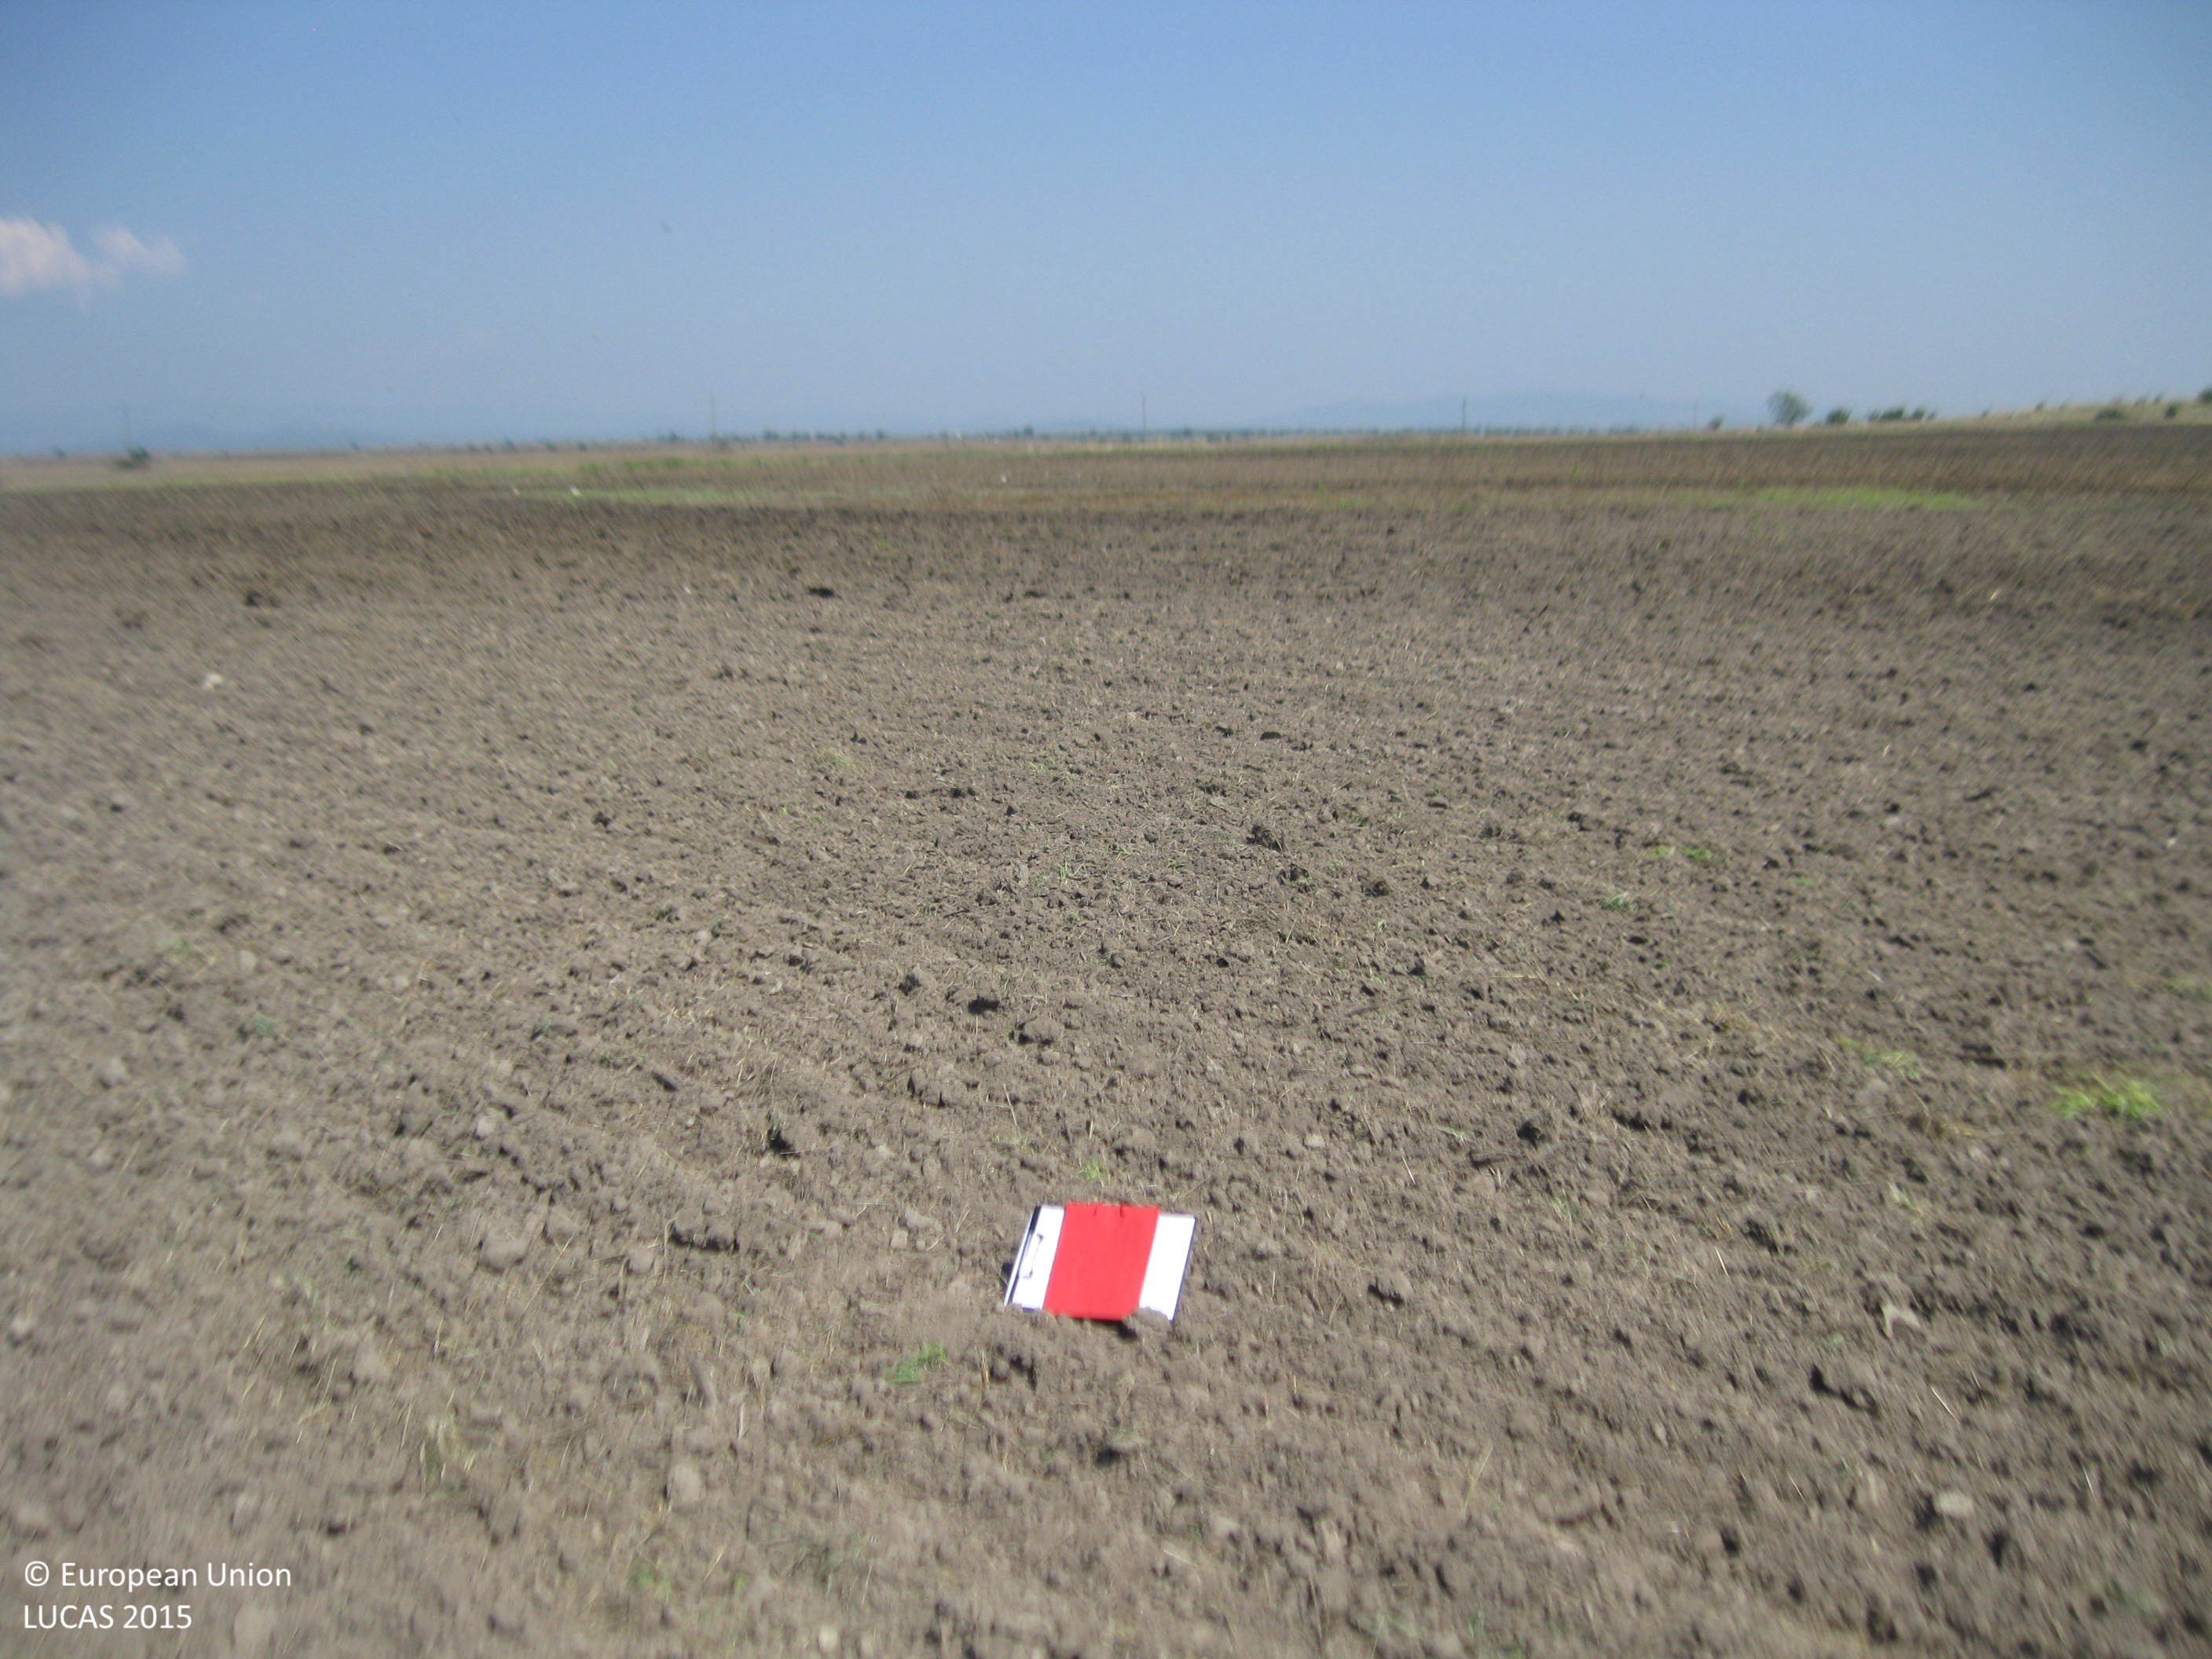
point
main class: Cropland
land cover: Common wheat
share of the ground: < 10 %
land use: Agriculture (excluding fallow land and kitchen gardens)
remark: Harvested field
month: September
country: BG
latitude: 42.2412
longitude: 25.0242
